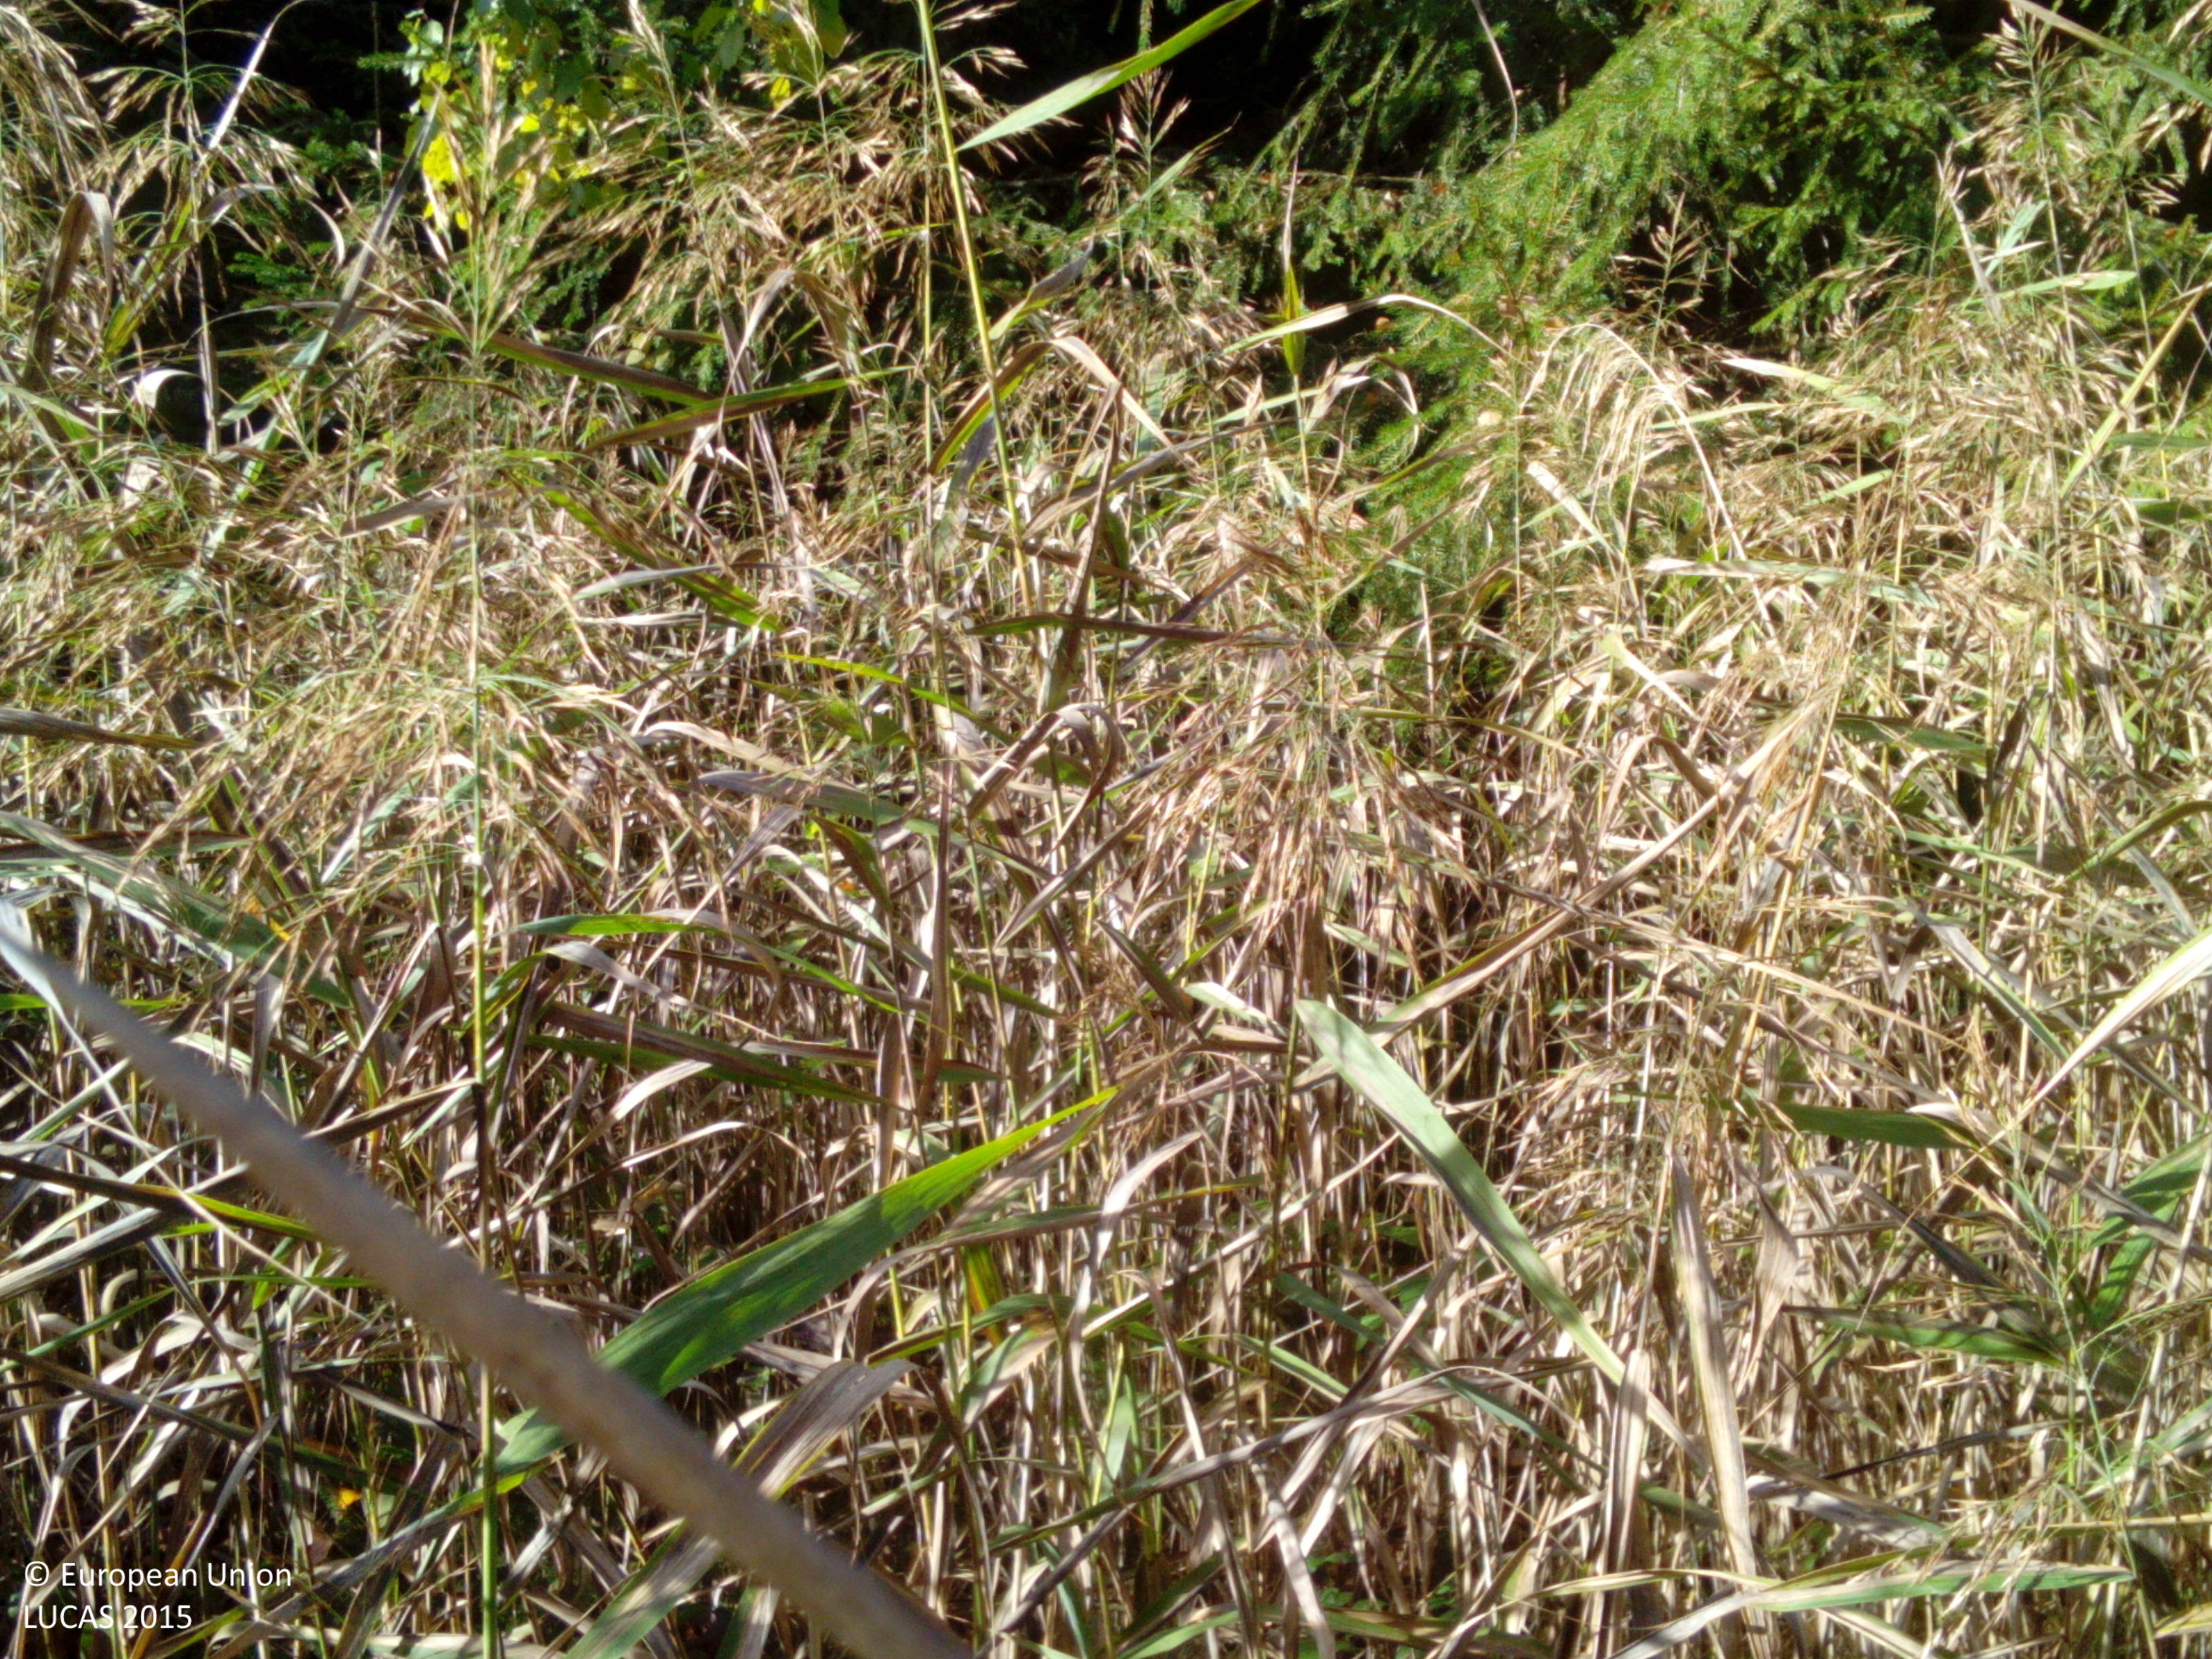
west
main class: Woodland
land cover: Broadleaved woodland
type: hemiboreal forest and nemoral coniferous forest and mixed broadleaved-coniferous forest
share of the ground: 50 - 75 %
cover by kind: broadleaved forest trees 65 %, herbaceous plants 25 %, coniferous forest trees 10 %
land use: Forestry
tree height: > 5 m
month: October
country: SE
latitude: 59.0098
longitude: 16.3146
